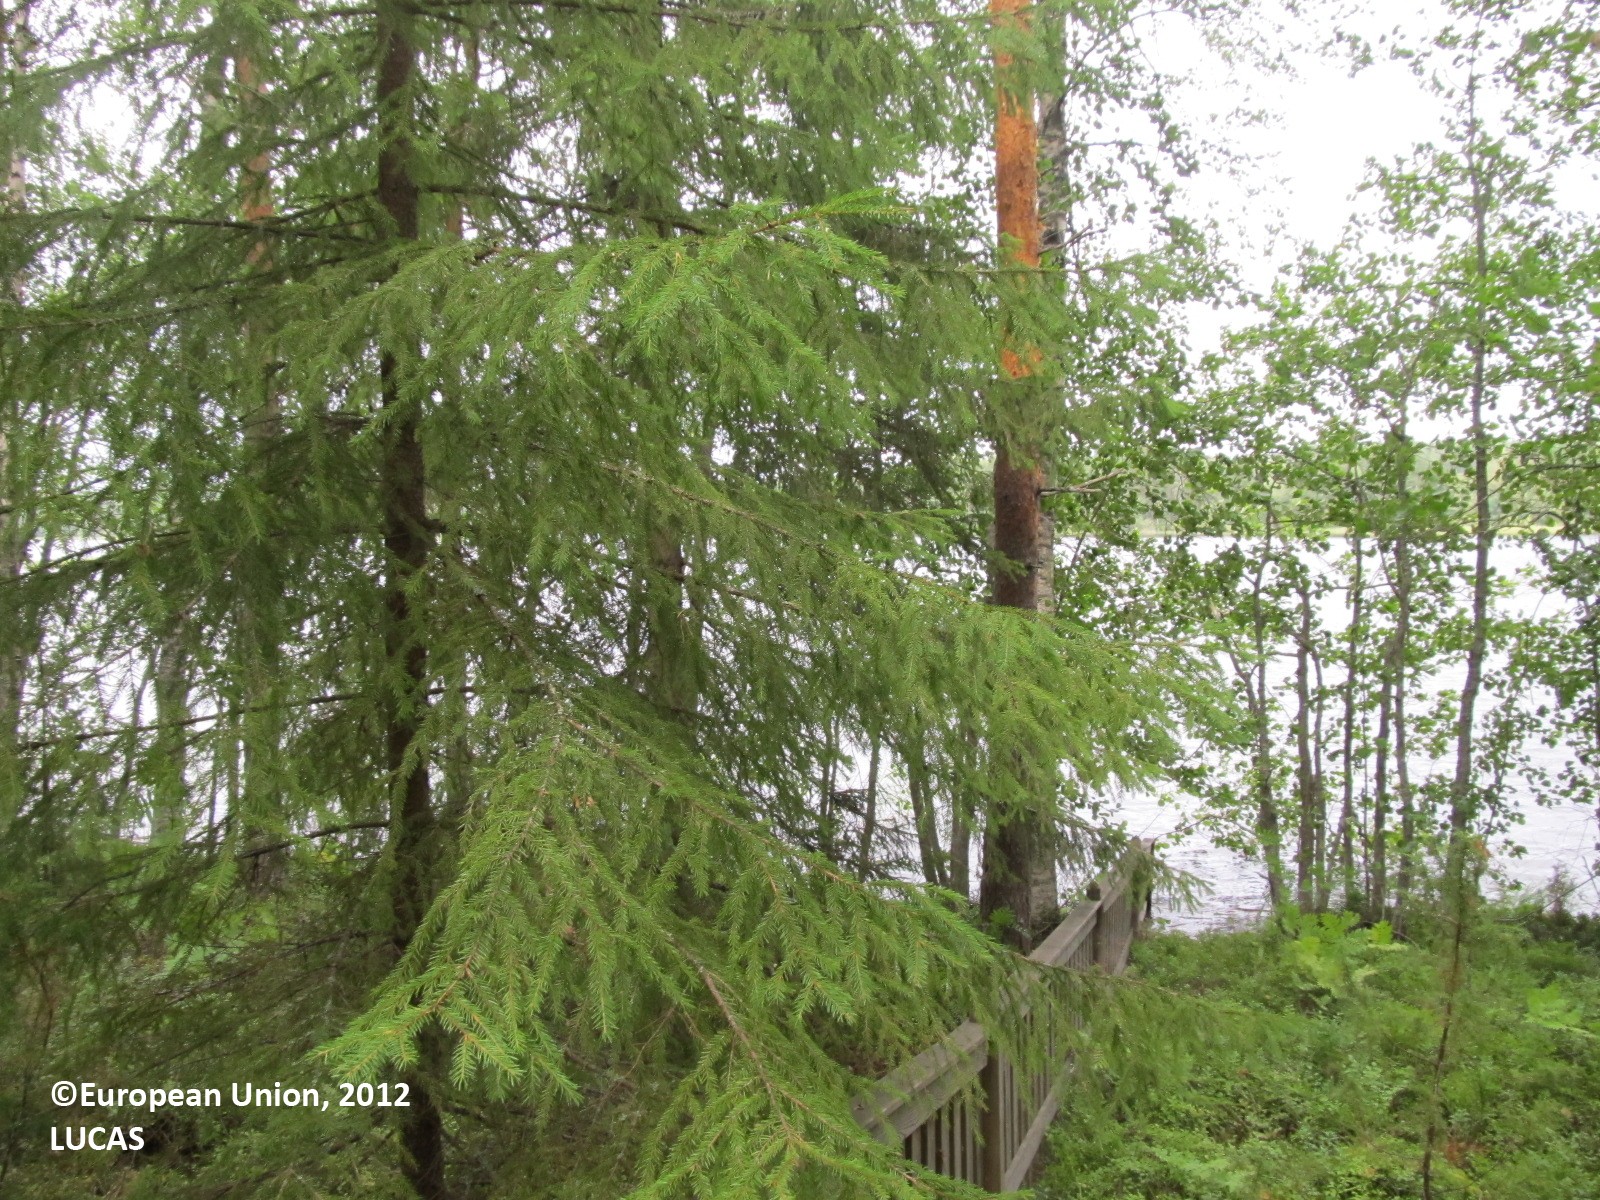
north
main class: Woodland
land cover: Spruce dominated mixed woodland
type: boreal forest
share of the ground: 25 - 50 %
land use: Forestry
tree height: > 5 m
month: August
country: FI
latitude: 62.1780
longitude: 28.0306
